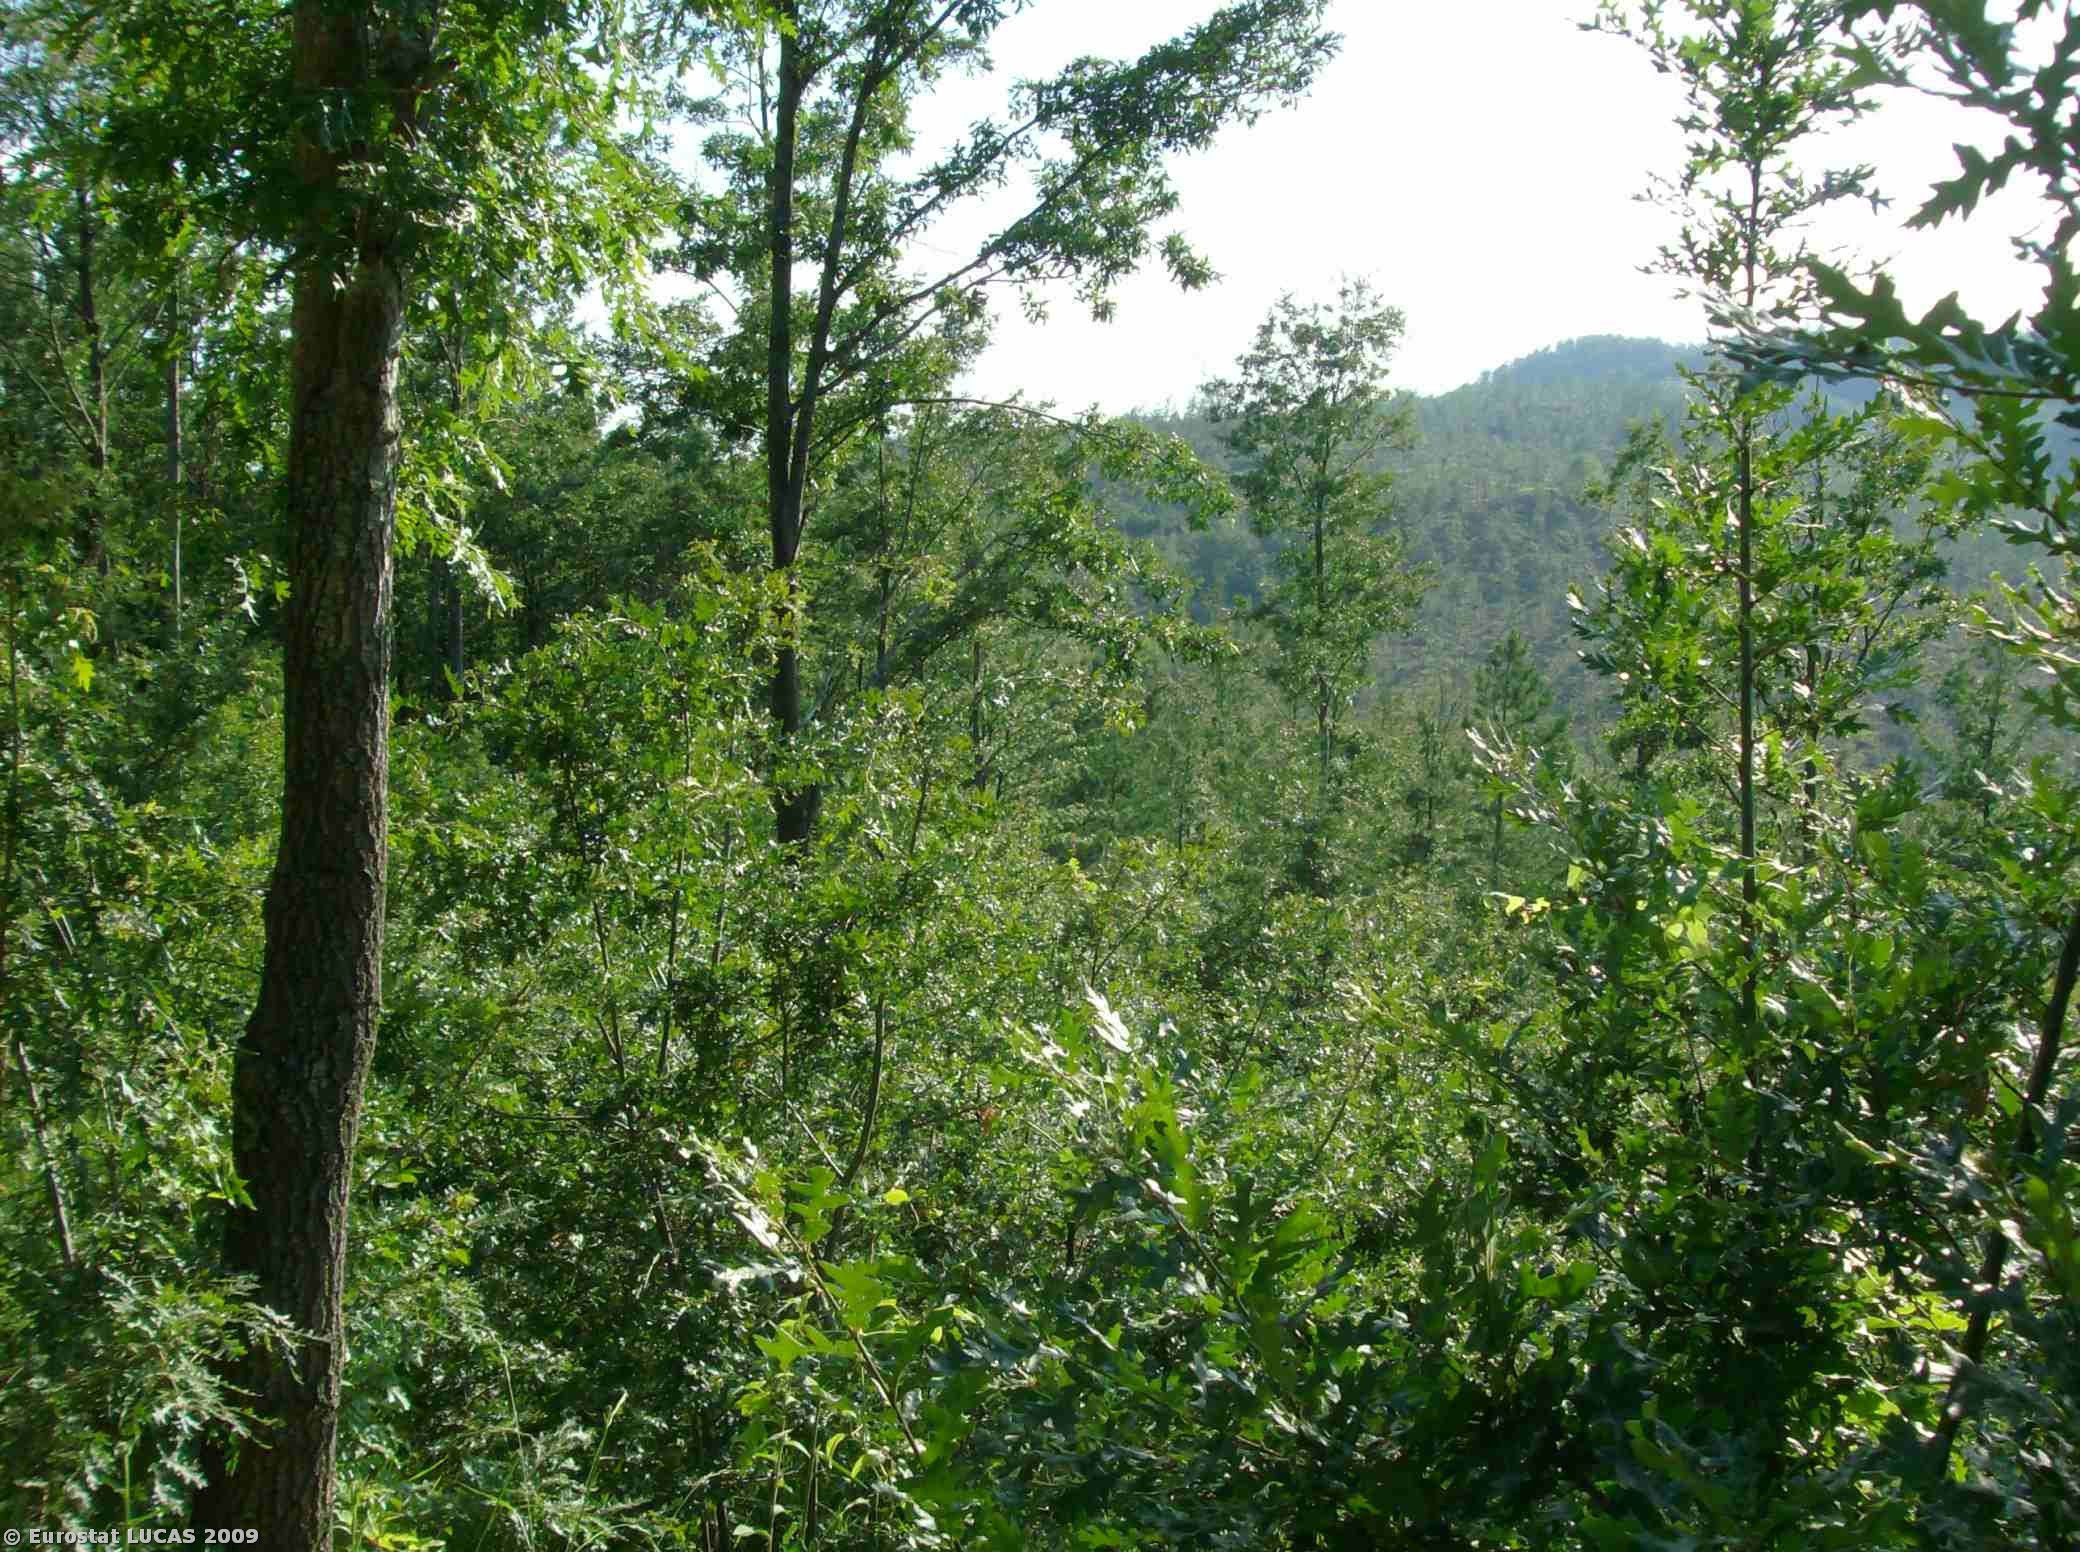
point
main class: Woodland
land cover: Mixed woodland
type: coniferous forest of the mediterranean region
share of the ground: > 75 %
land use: Forestry
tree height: > 5 m
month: June
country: IT
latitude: 42.7856
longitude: 11.6206
